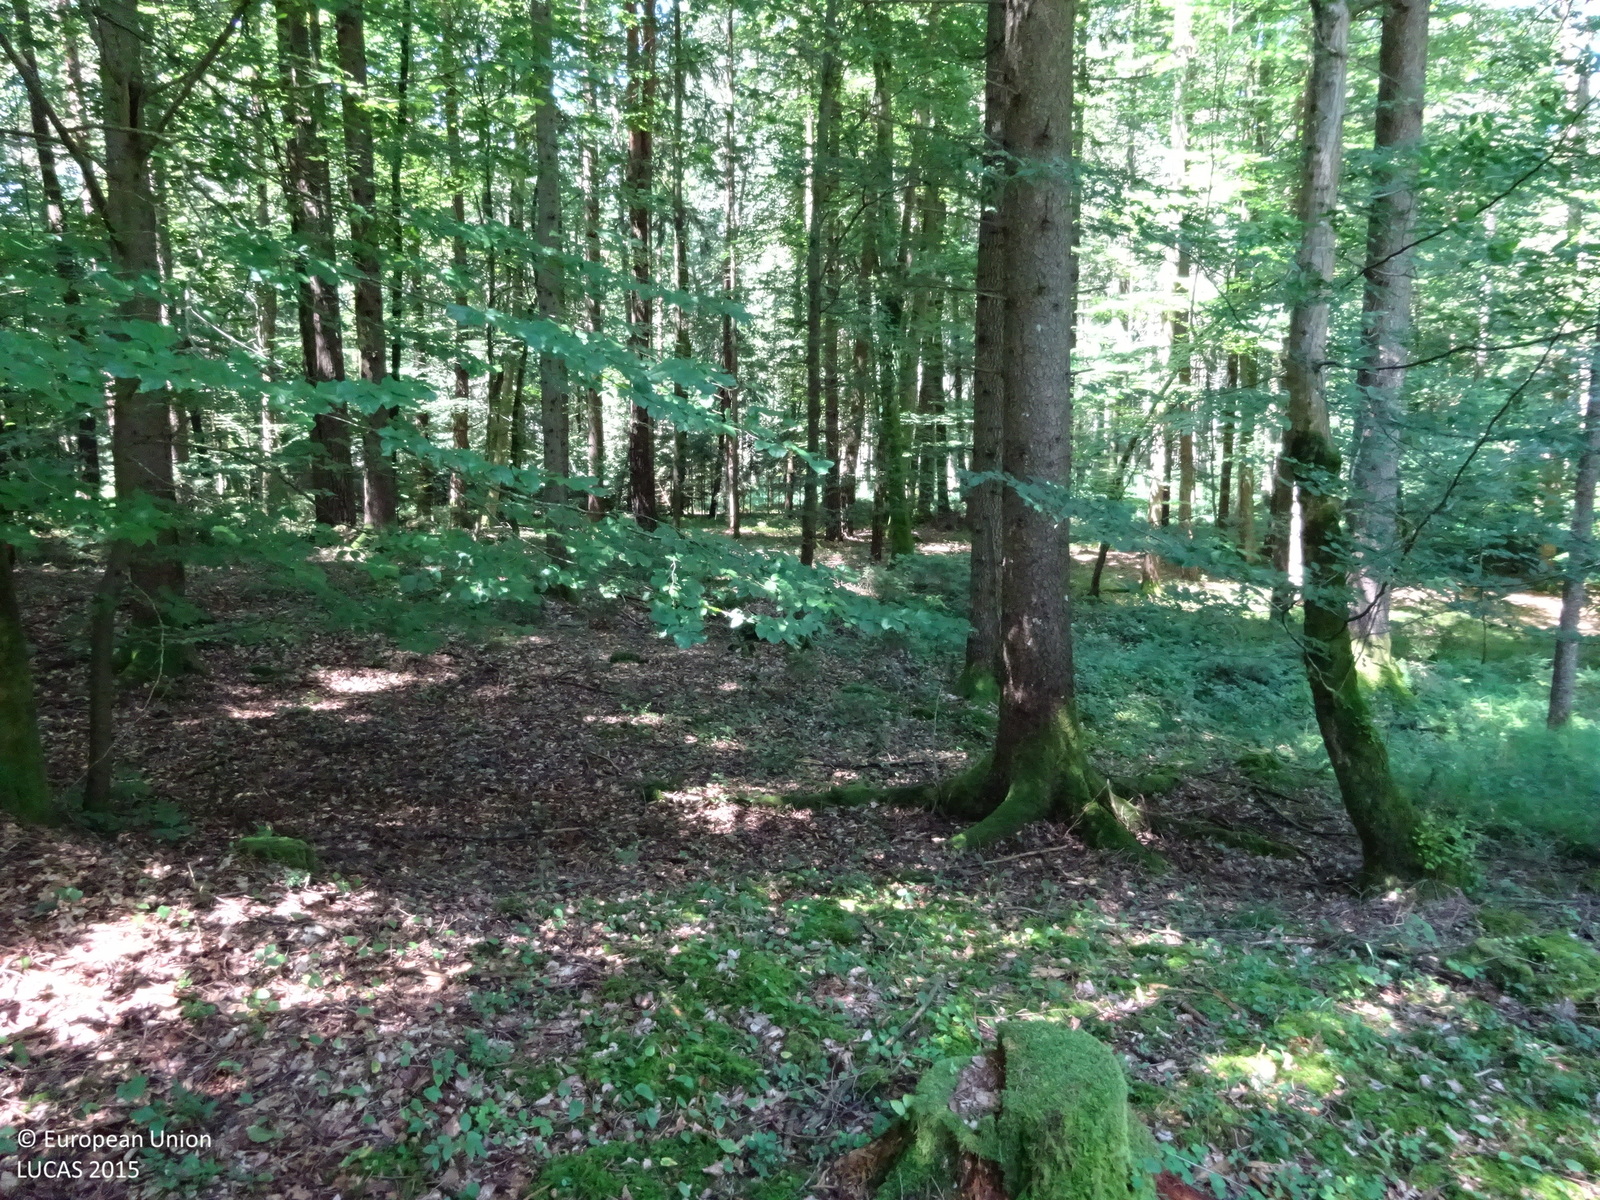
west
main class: Woodland
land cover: Spruce dominated mixed woodland
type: mountainous beech forest
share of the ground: > 75 %
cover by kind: broadleaved forest trees 60 %, coniferous forest trees 30 %, herbaceous plants 5 %, lichens and mosses 5 %
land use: Forestry
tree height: > 5 m
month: July
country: AT
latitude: 46.8869
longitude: 15.3142
